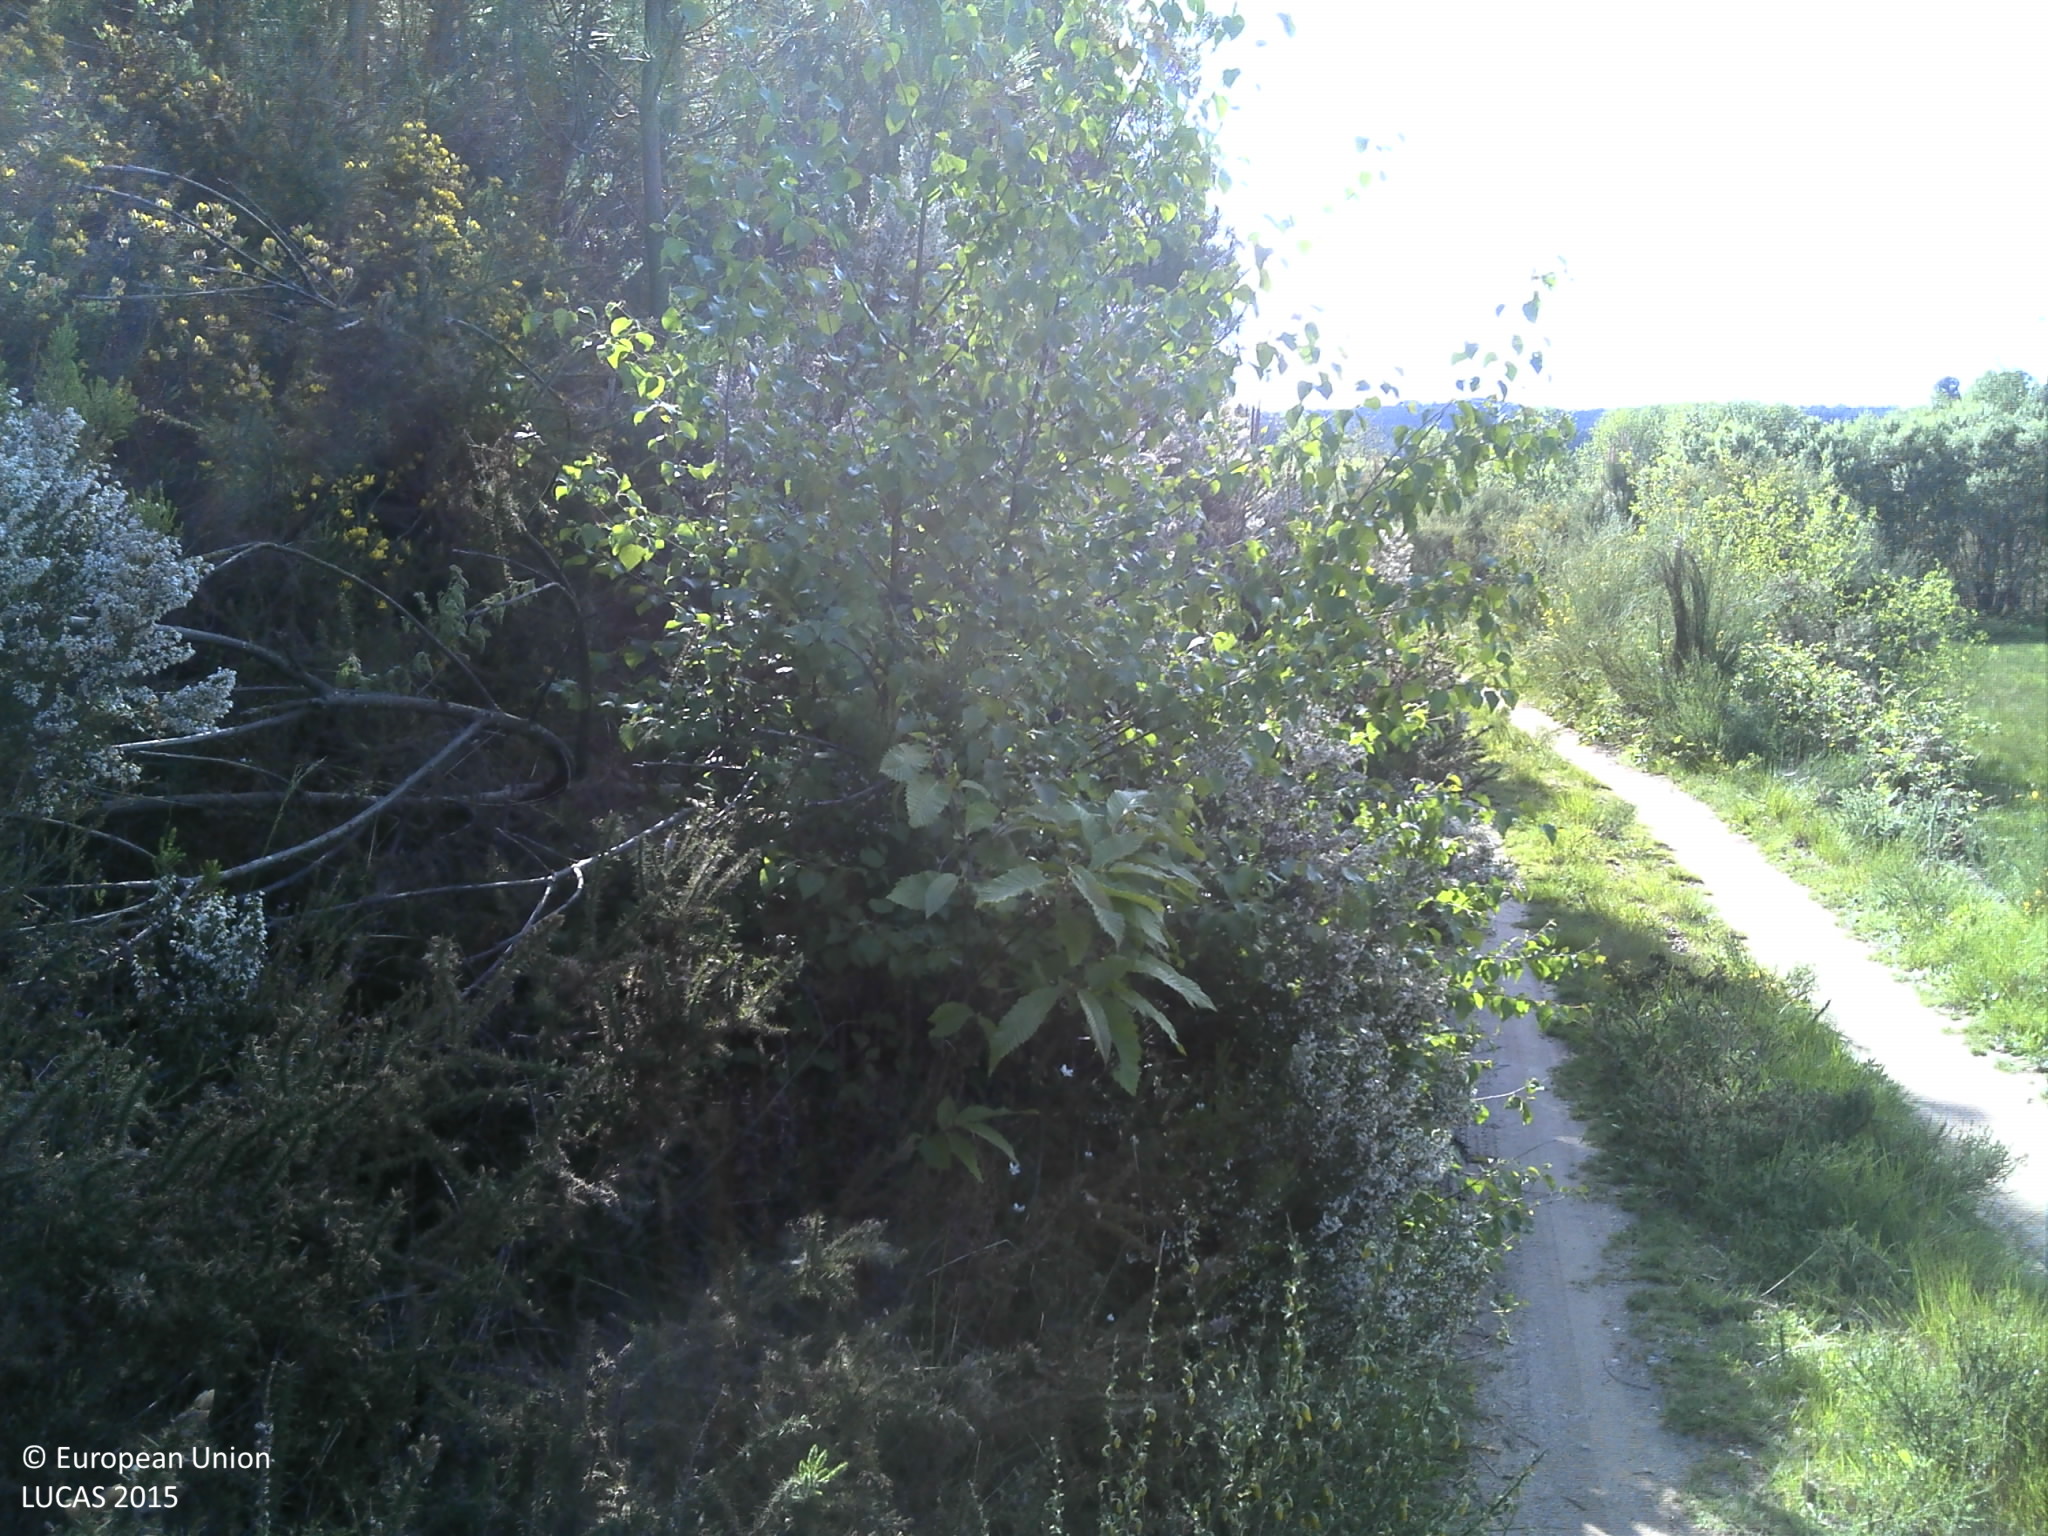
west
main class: Woodland
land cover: Pine dominated coniferous woodland
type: coniferous forest of the mediterranean region
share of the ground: > 75 %
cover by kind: coniferous forest trees 60 %, shrubs 35 %, unconsolidated bare surface 5 %
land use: Forestry
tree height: < 5 m
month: May
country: PT
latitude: 41.5068
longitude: -7.5855
